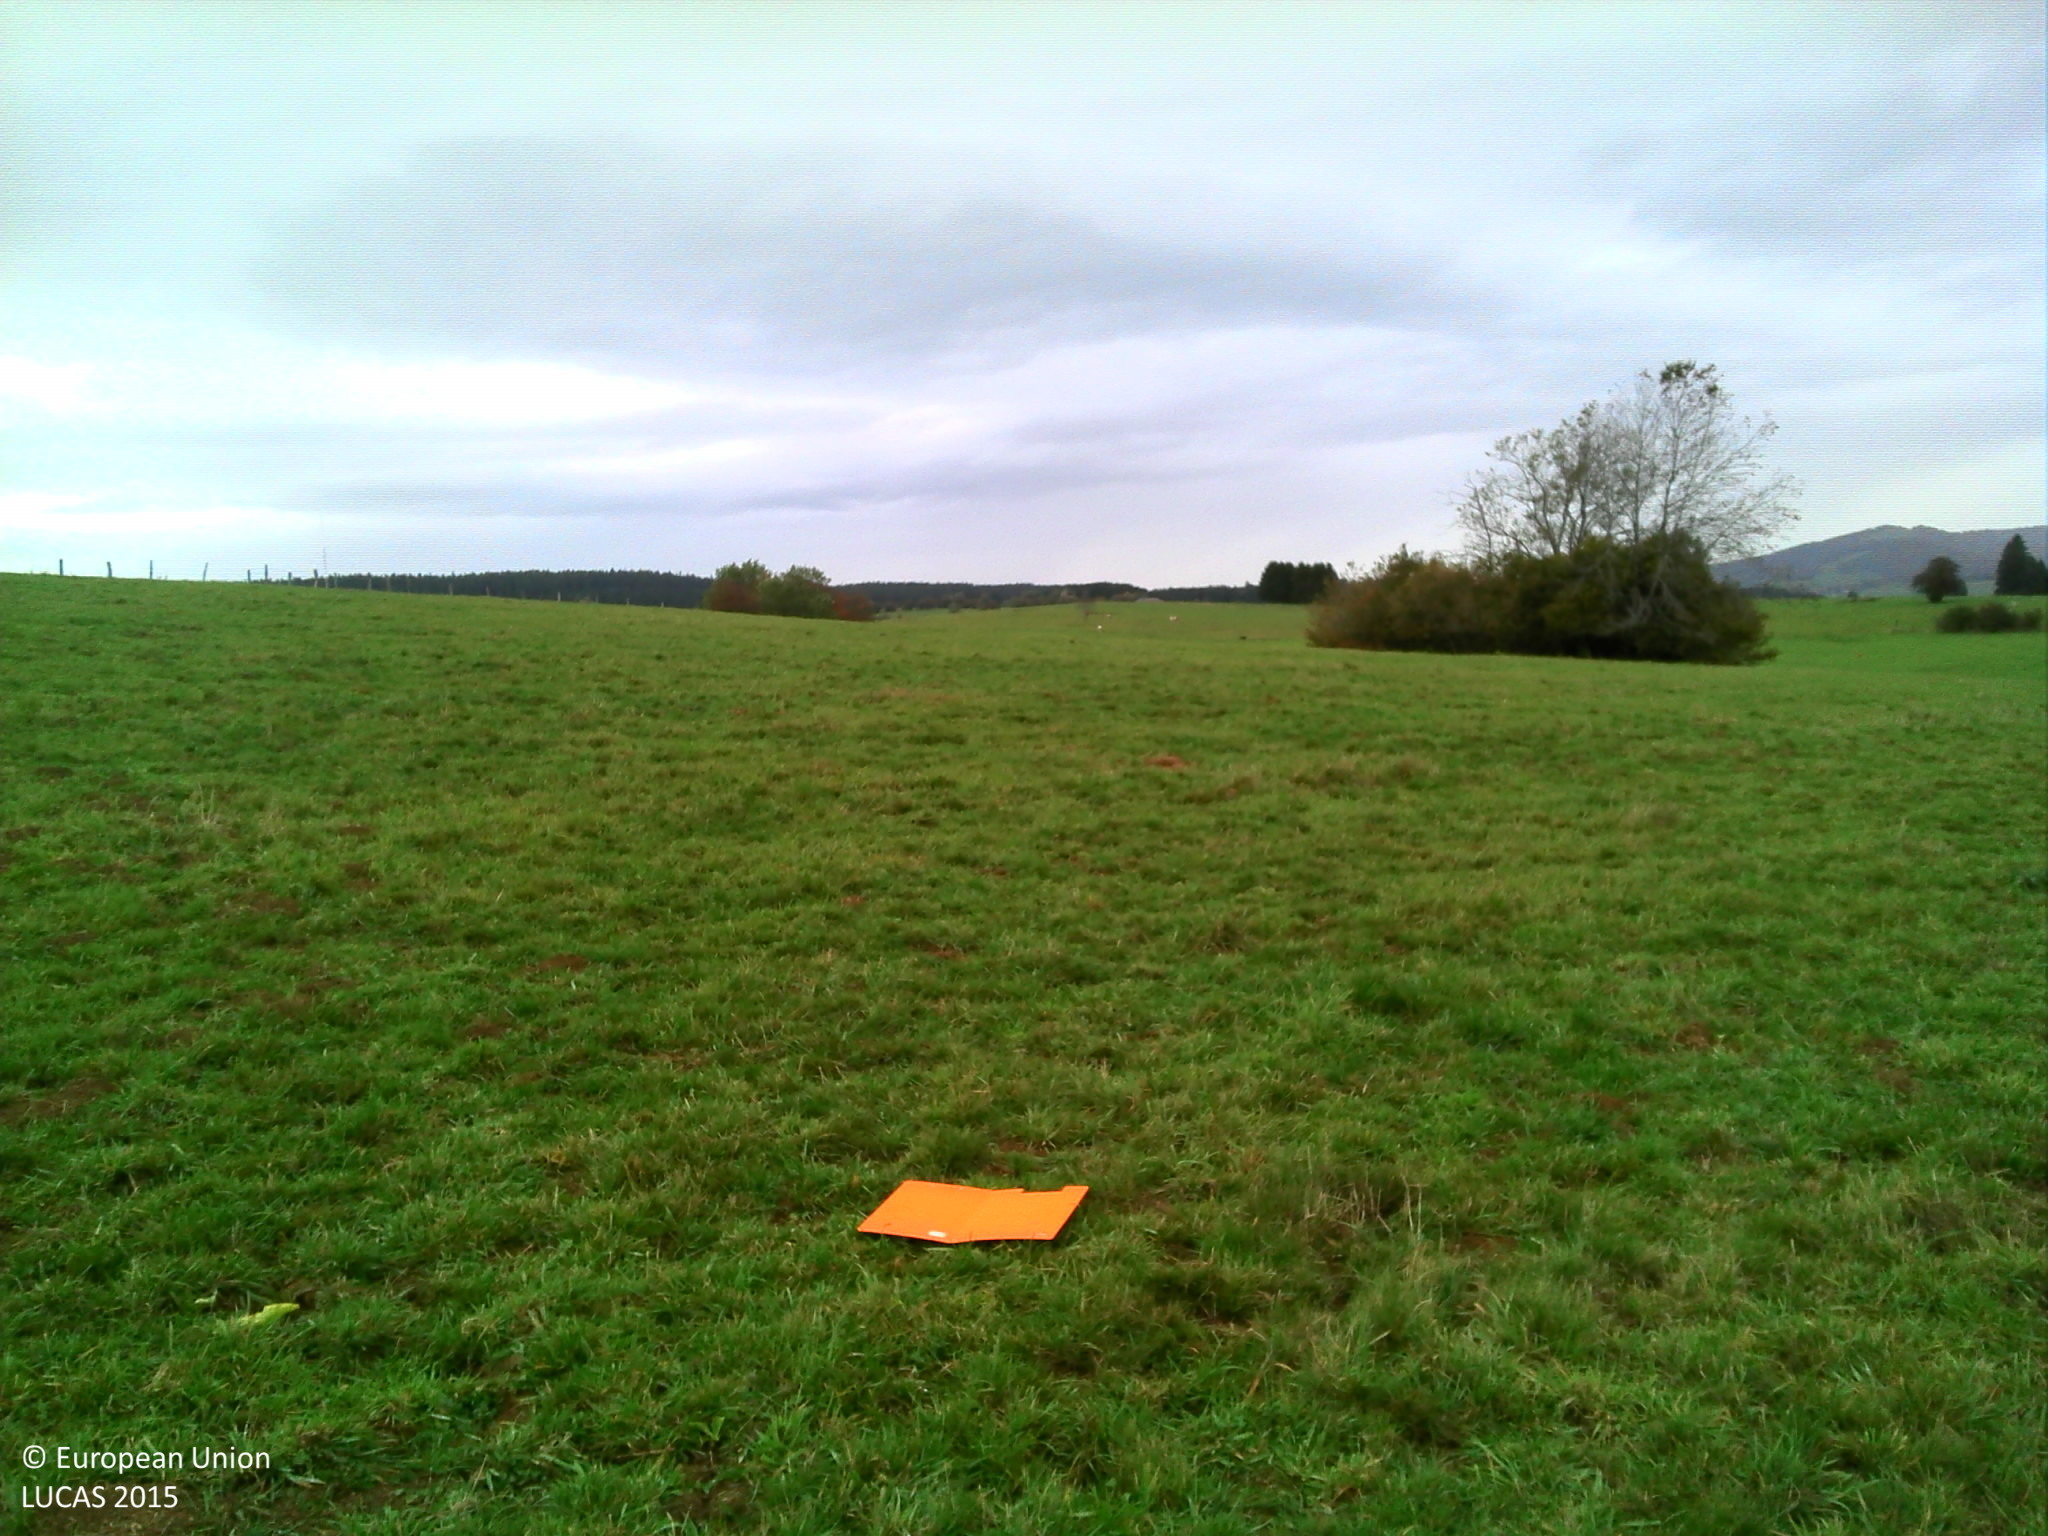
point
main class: Grassland
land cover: Grassland without tree/shrub cover
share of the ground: > 75 %
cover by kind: herbaceous plants 100 %
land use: Agriculture (excluding fallow land and kitchen gardens)
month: October
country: FR
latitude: 46.9546
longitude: 6.3100
